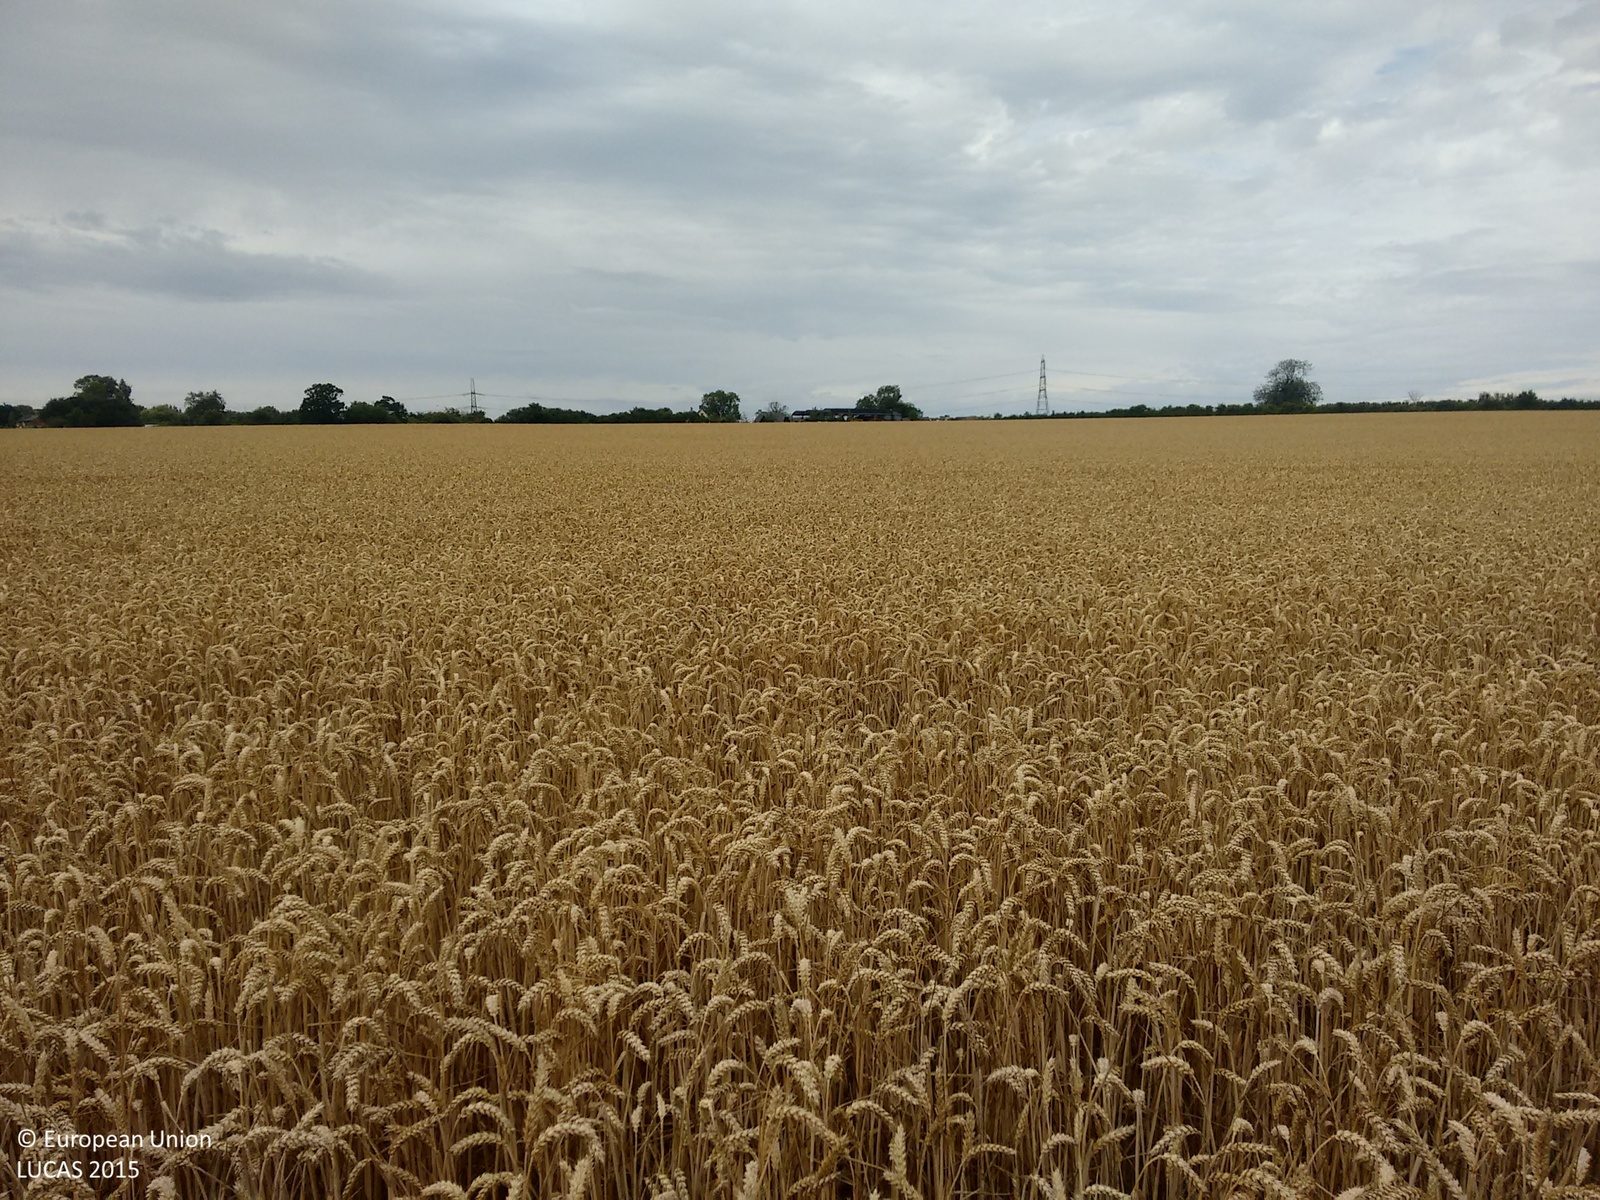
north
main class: Cropland
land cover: Common wheat
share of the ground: > 75 %
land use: Agriculture (excluding fallow land and kitchen gardens)
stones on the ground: 10 - 25 %
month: August
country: GB
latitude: 51.9950
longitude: 0.4909
